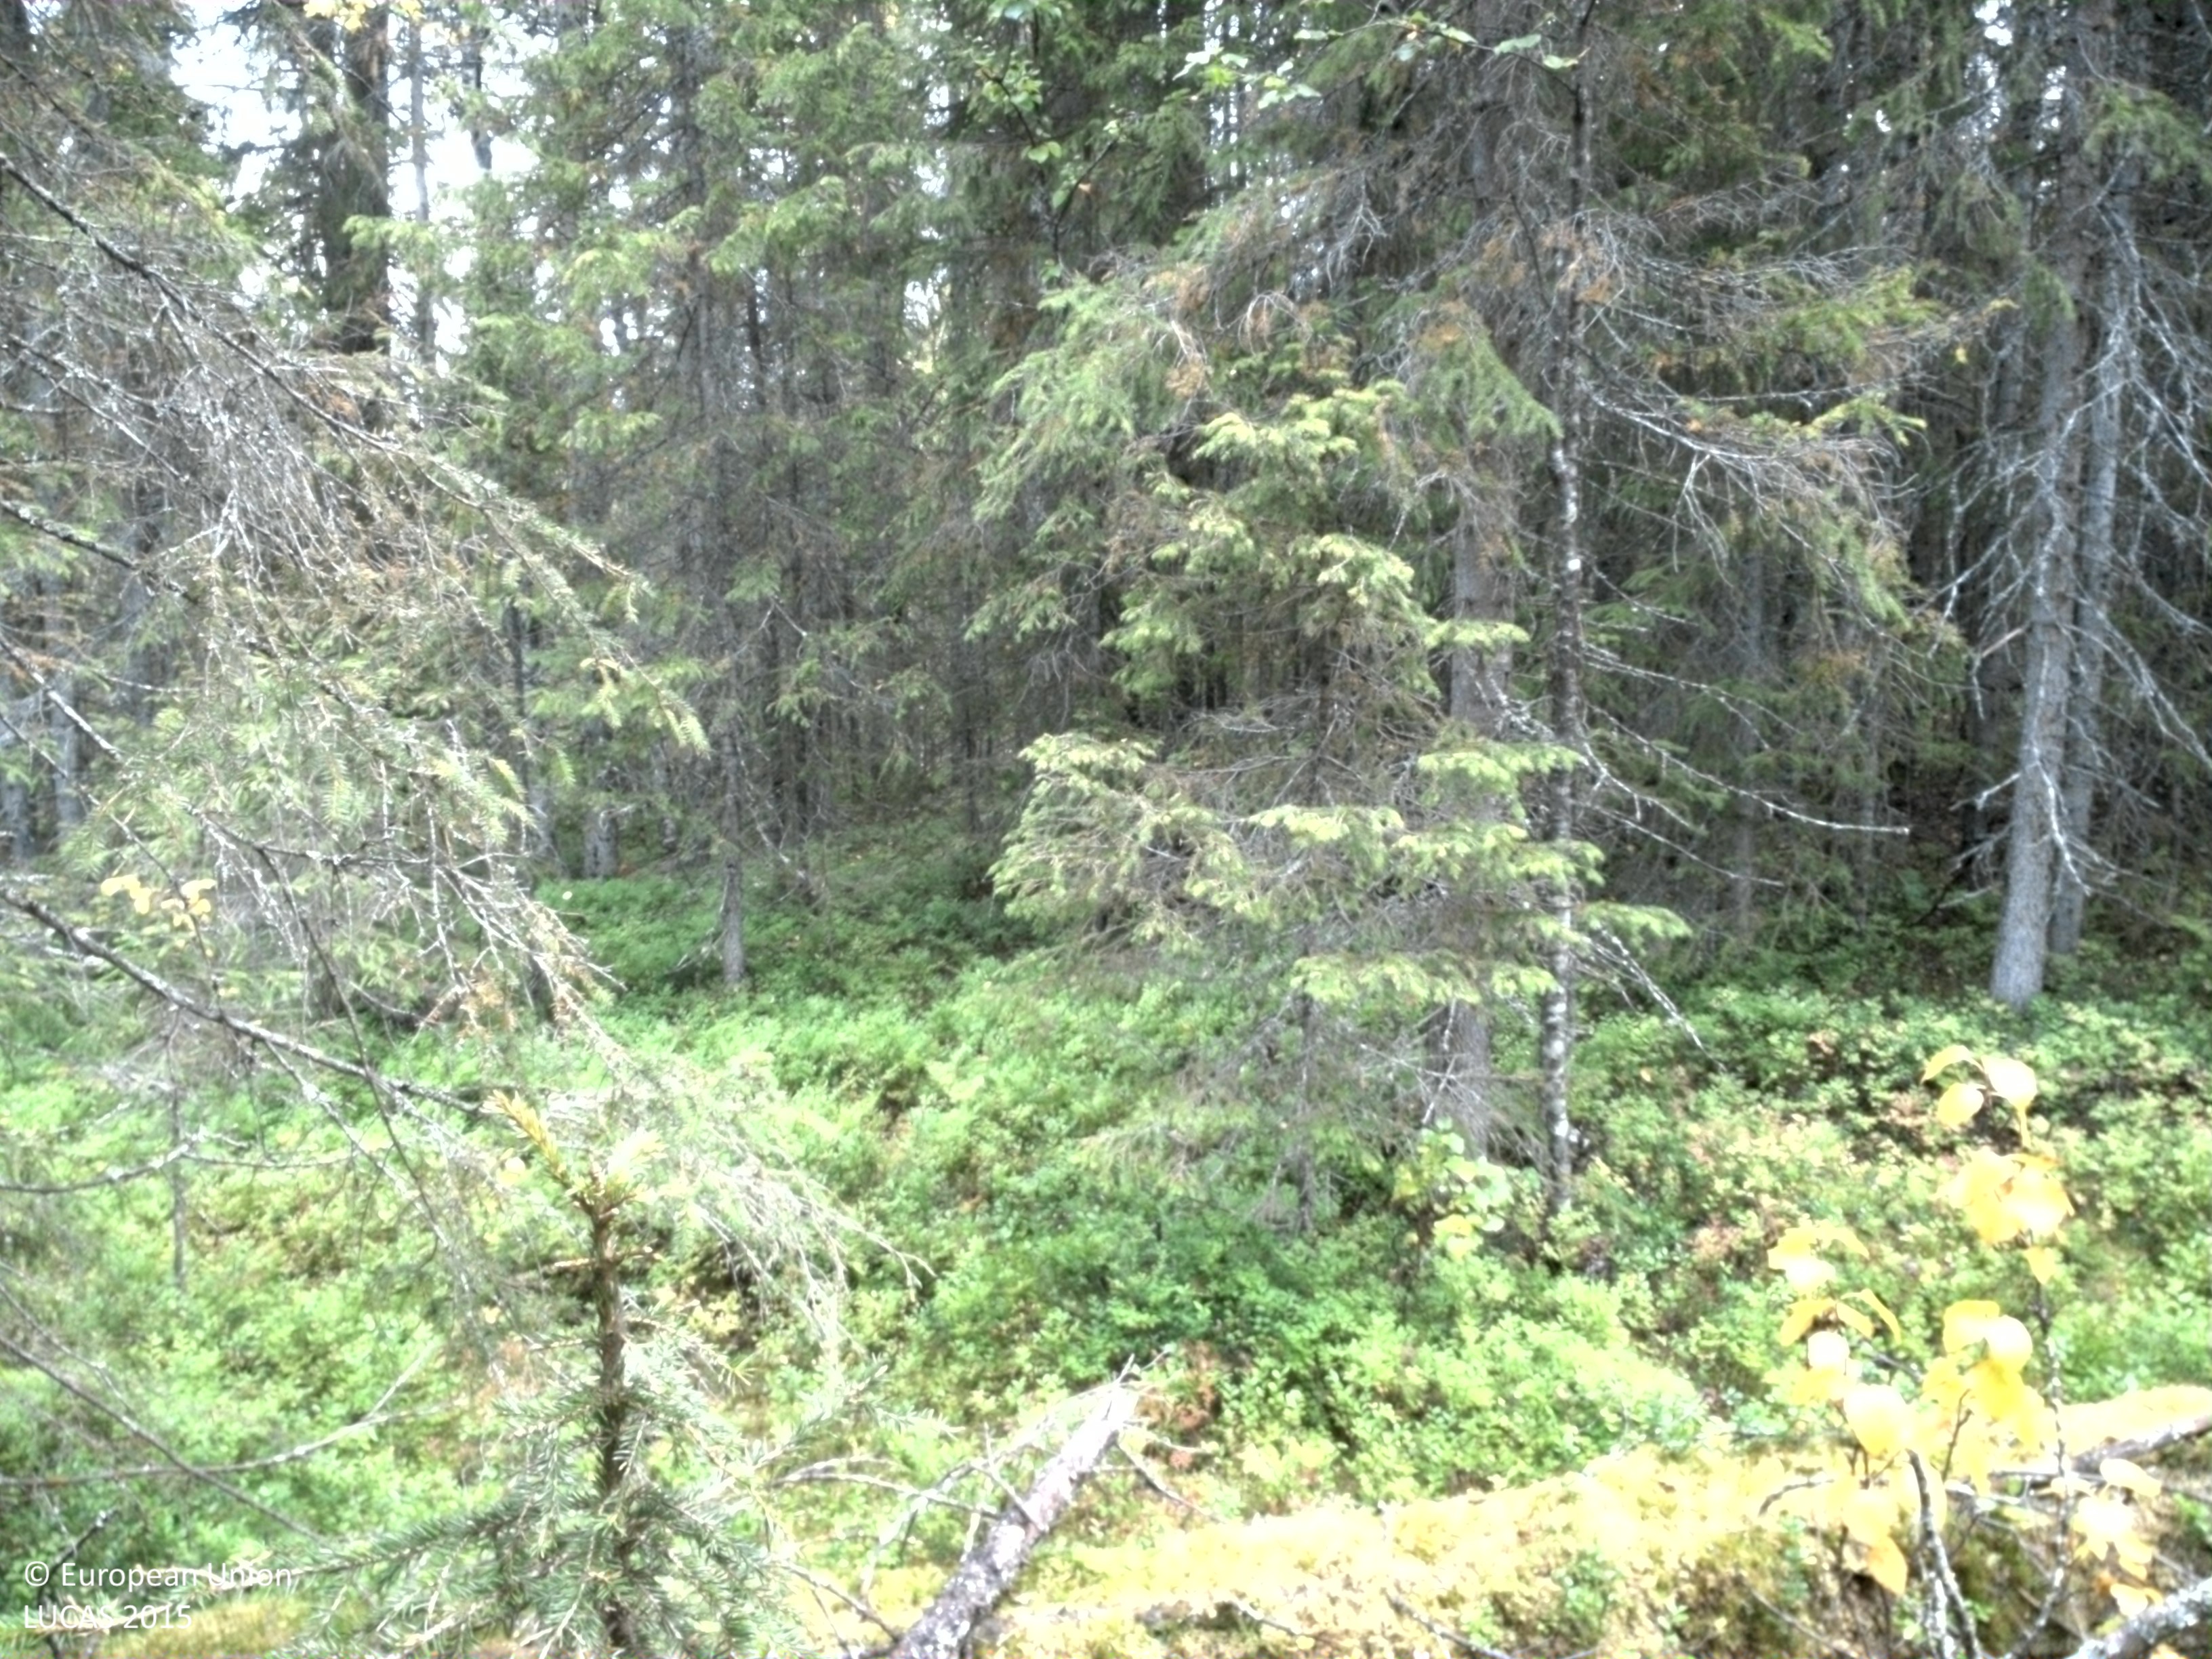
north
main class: Woodland
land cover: Spruce dominated coniferous woodland
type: boreal forest
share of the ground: 50 - 75 %
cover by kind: coniferous forest trees 45 %, shrubs 40 %, lichens and mosses 10 %, broadleaved forest trees 5 %
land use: Forestry
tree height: > 5 m
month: September
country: SE
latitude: 65.2950
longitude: 16.5886
